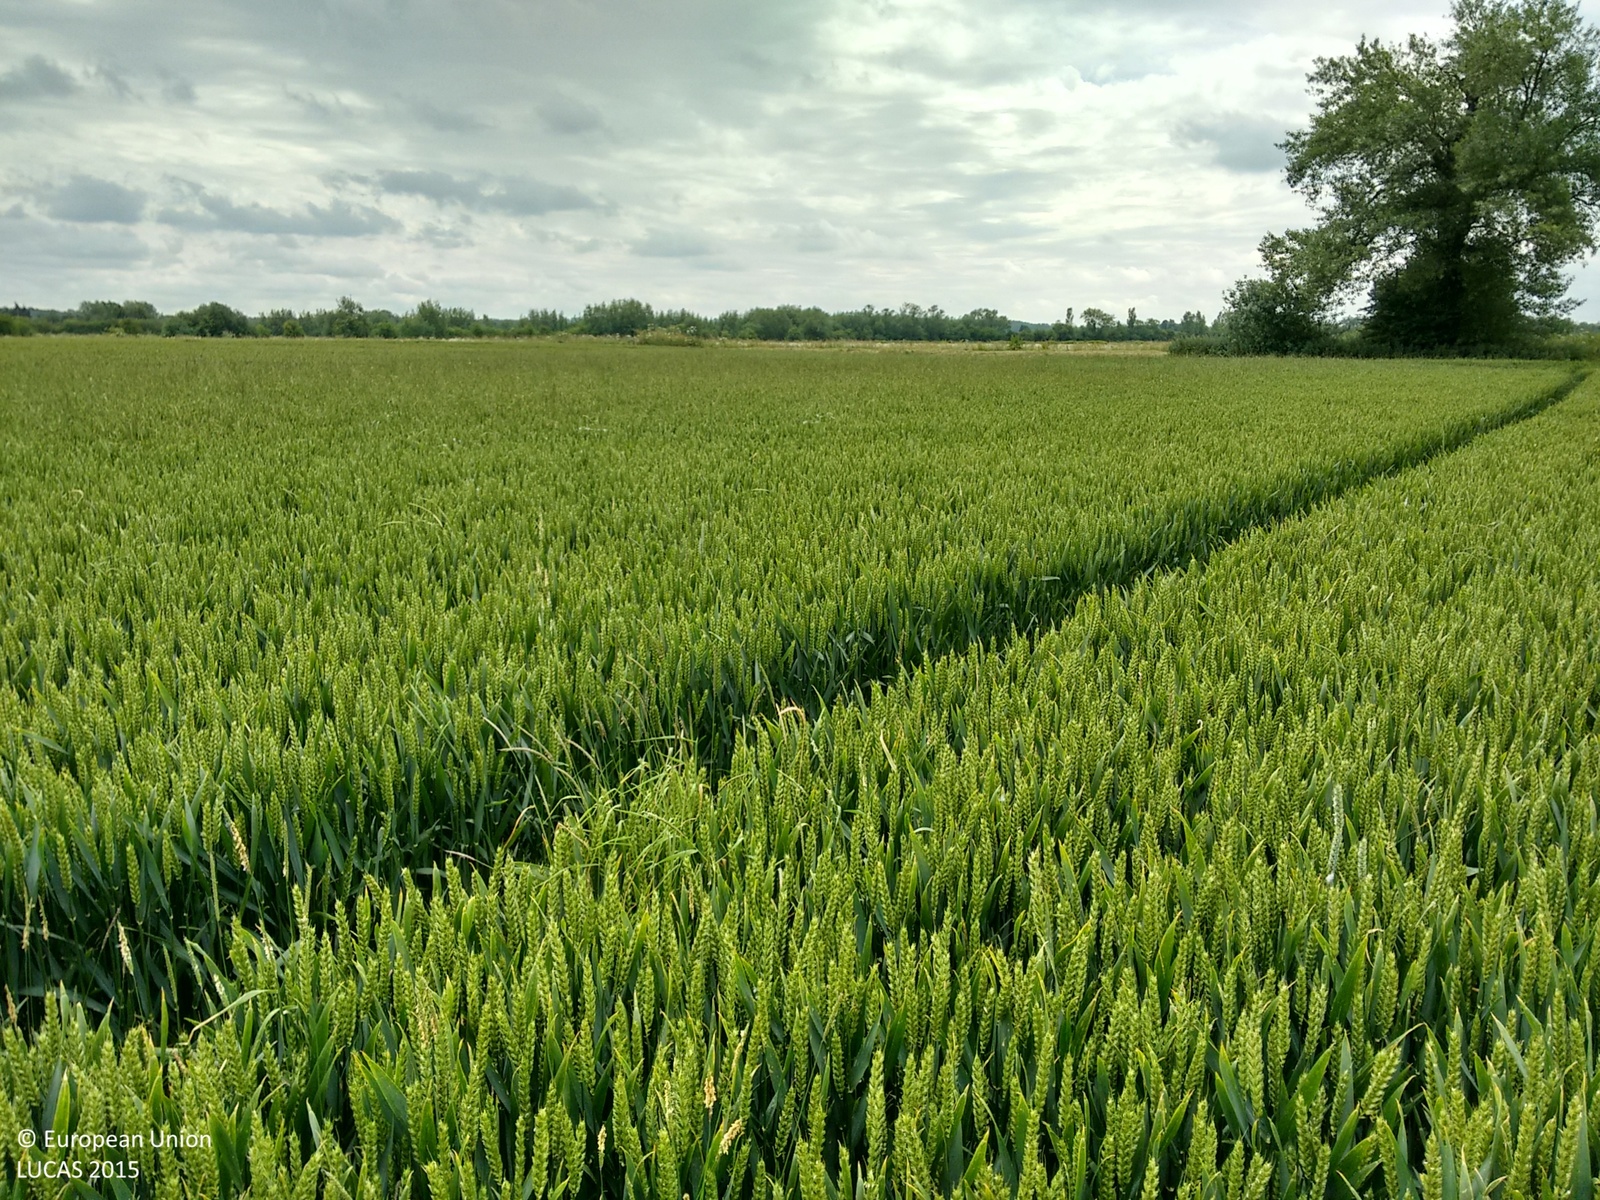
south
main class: Cropland
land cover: Common wheat
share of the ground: > 75 %
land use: Agriculture (excluding fallow land and kitchen gardens)
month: June
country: GB
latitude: 51.6963
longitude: -1.6126
